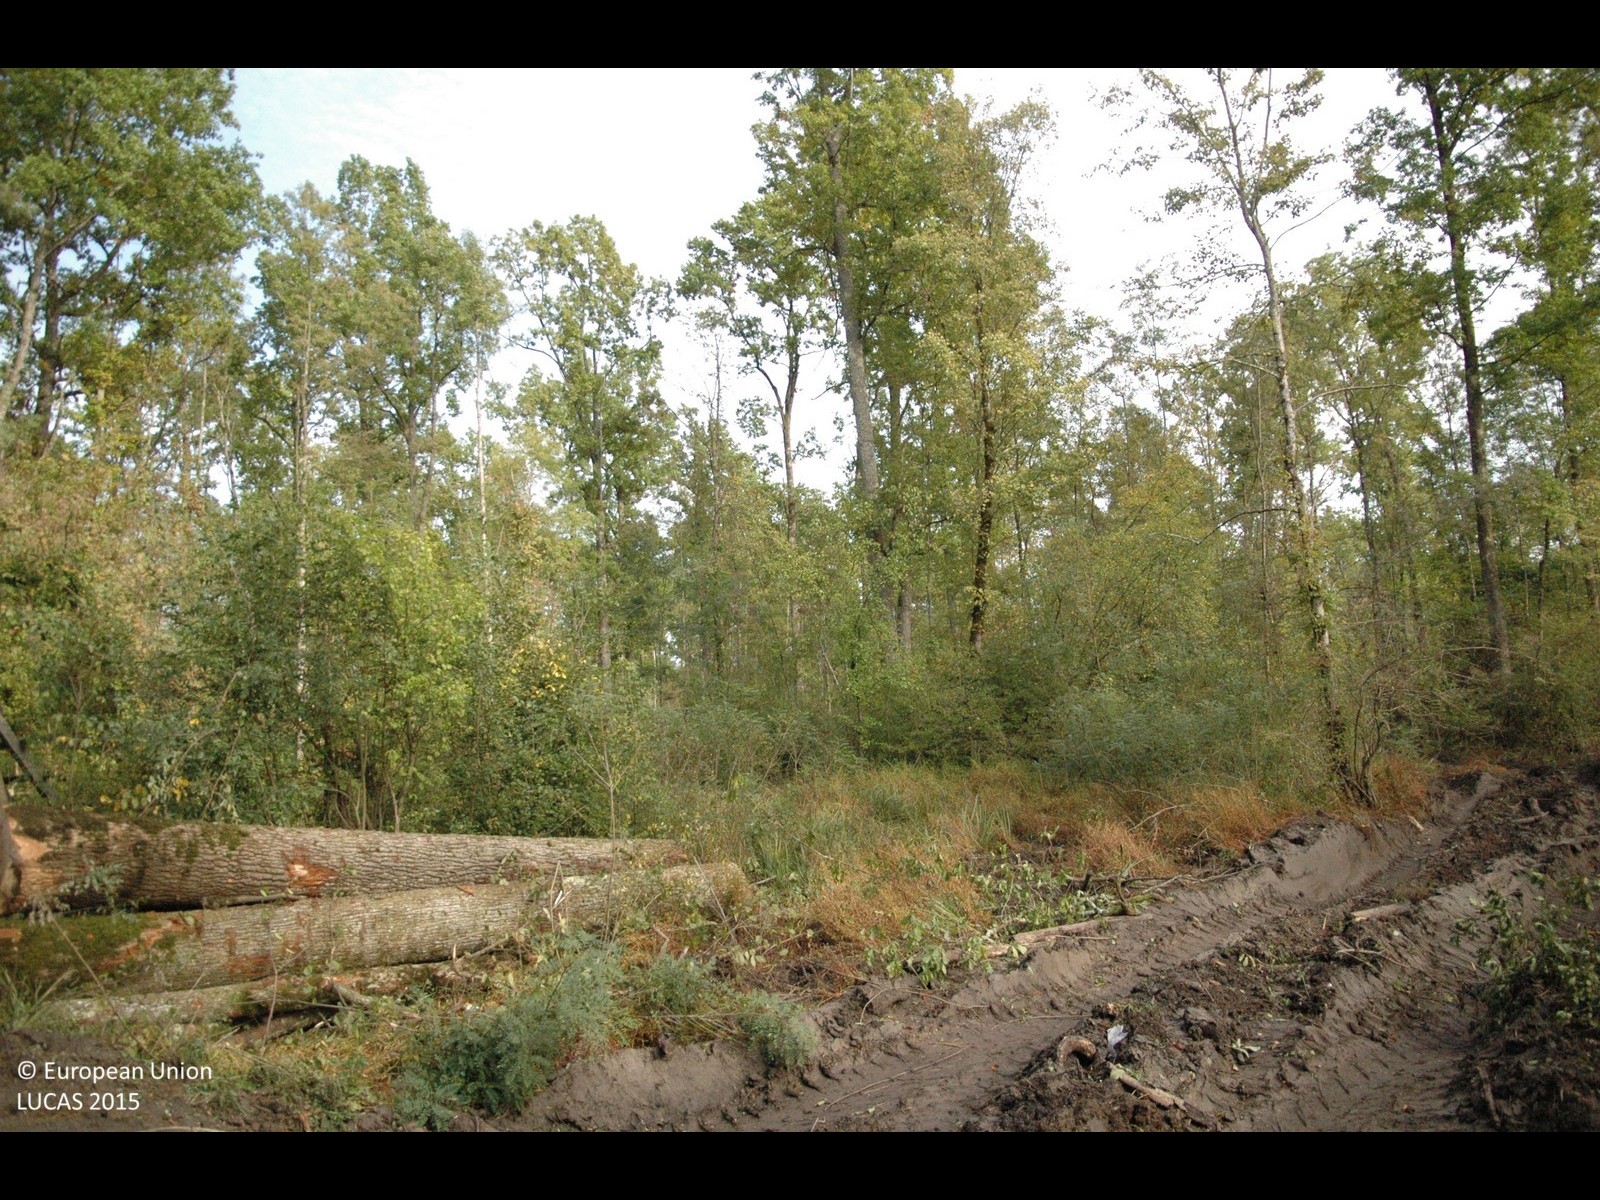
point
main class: Woodland
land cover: Broadleaved woodland
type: floodplain forest
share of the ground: > 75 %
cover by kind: broadleaved forest trees 100 %
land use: Forestry
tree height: > 5 m
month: October
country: HR
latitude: 45.5878
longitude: 16.2914
